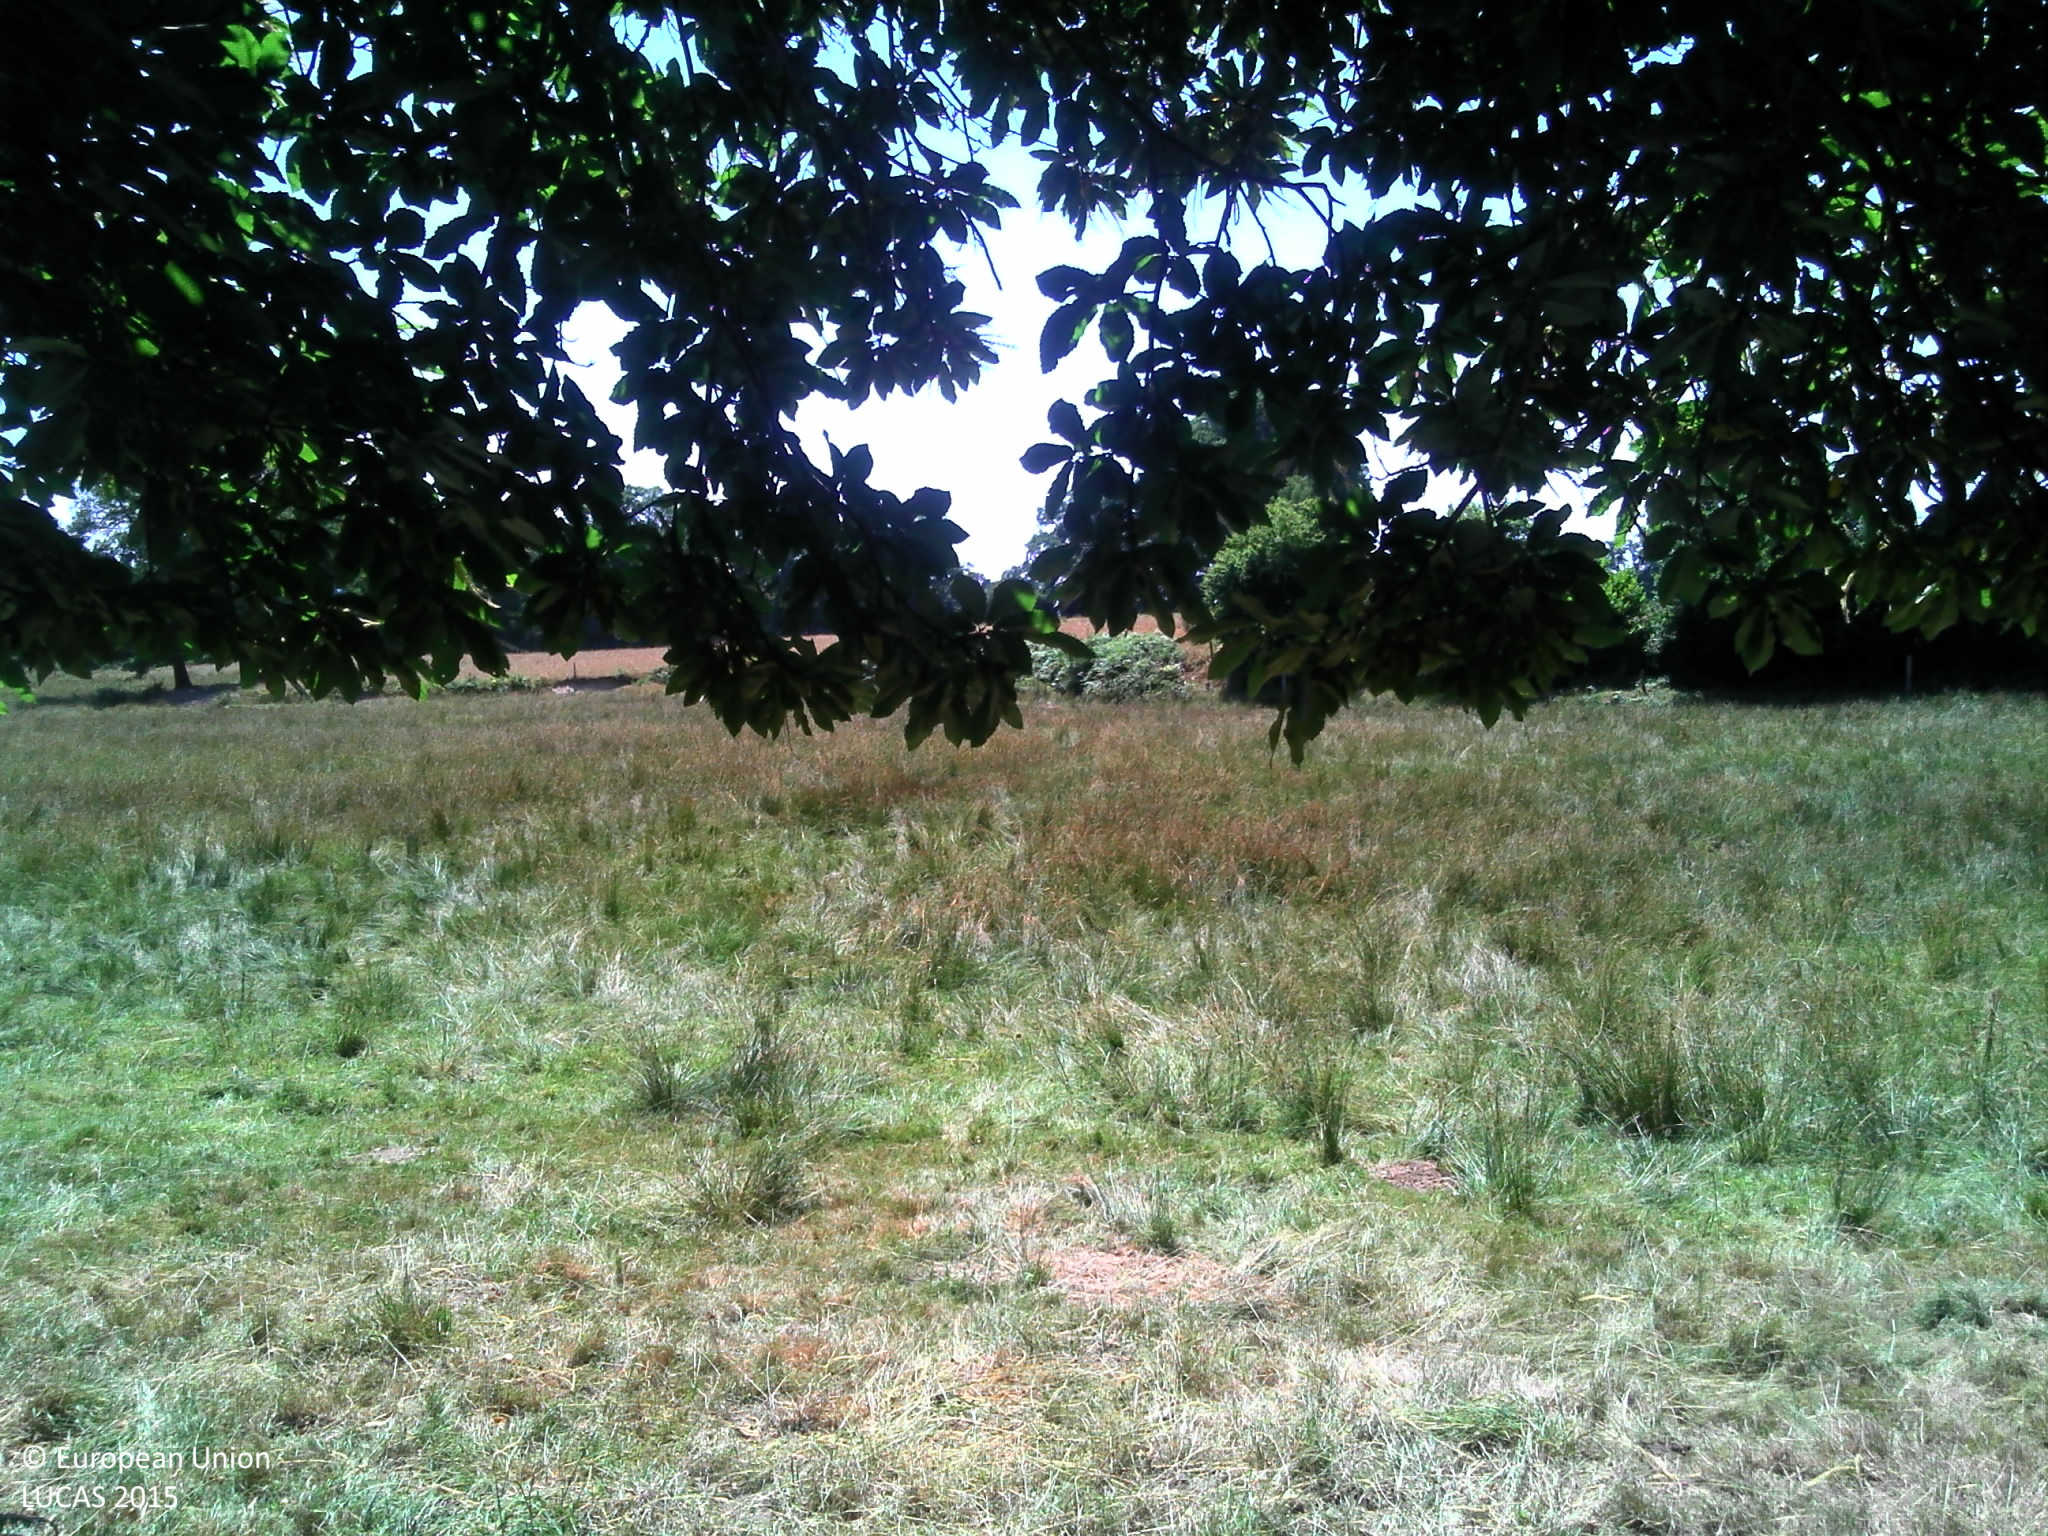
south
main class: Woodland
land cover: Broadleaved woodland
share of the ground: > 75 %
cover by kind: broadleaved forest trees 65 %, herbaceous plants 35 %
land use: Agriculture (excluding fallow land and kitchen gardens)
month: July
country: FR
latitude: 46.2039
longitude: 1.6323
